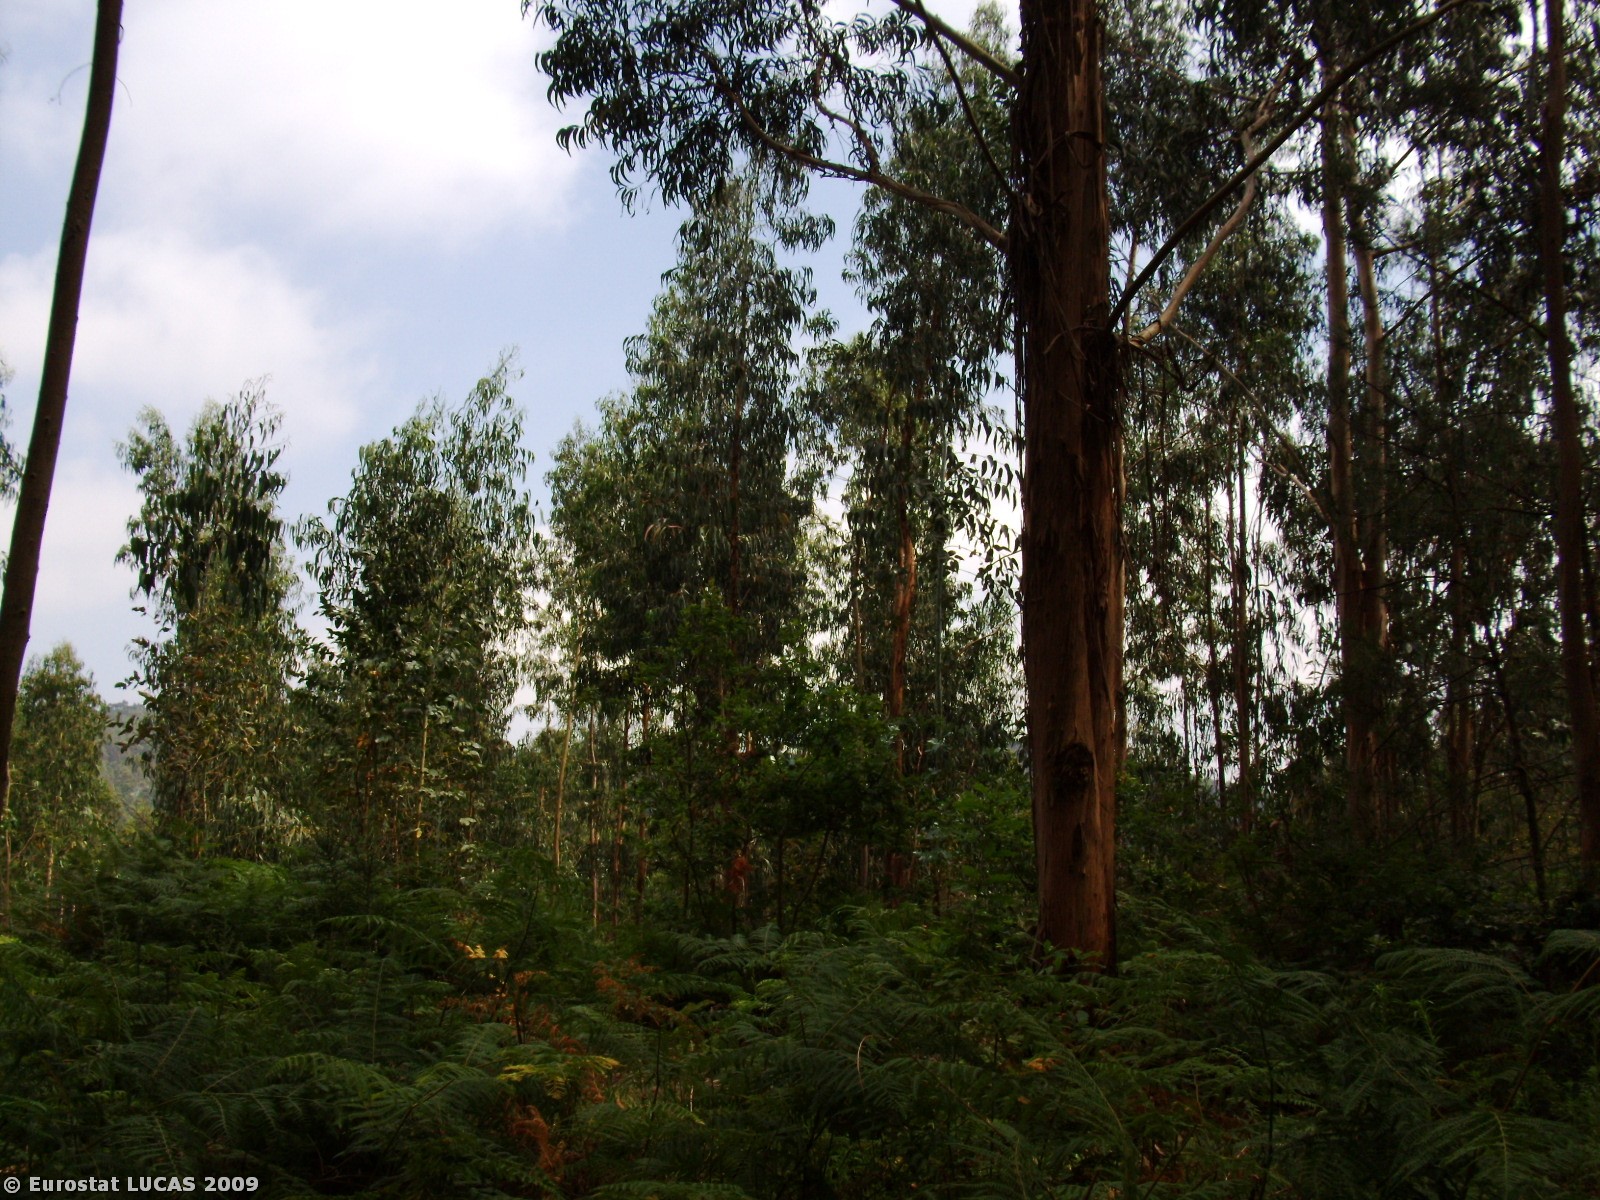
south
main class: Woodland
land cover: Broadleaved woodland
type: plantations and self-sown exotic forest
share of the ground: 50 - 75 %
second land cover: Spontaneously vegetated surfaces
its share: 50 - 75 %
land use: Forestry
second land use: Unused
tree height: > 5 m
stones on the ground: < 10 %
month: June
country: PT
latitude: 41.4357
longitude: -8.4759
